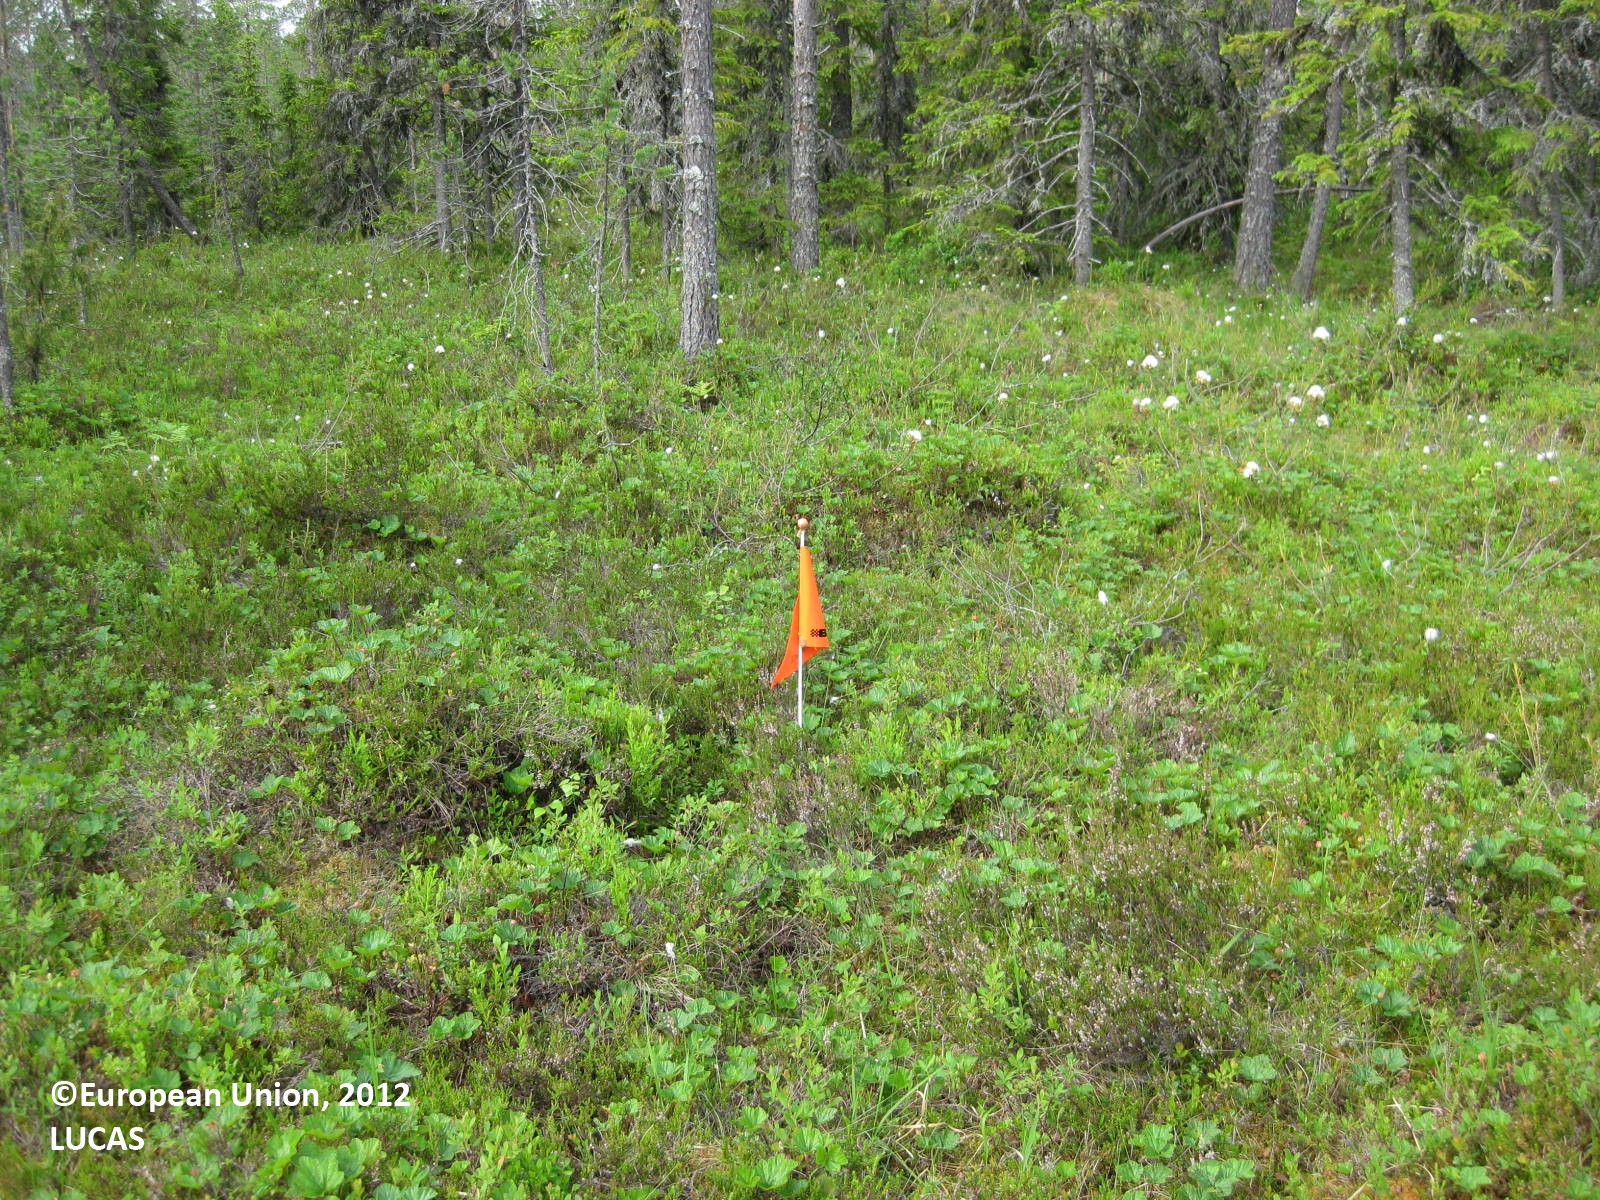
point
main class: Woodland
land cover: Other coniferous woodland
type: mire and swamp forests
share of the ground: 25 - 50 %
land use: Forestry
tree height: > 5 m
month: July
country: FI
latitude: 65.5865
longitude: 29.2015
